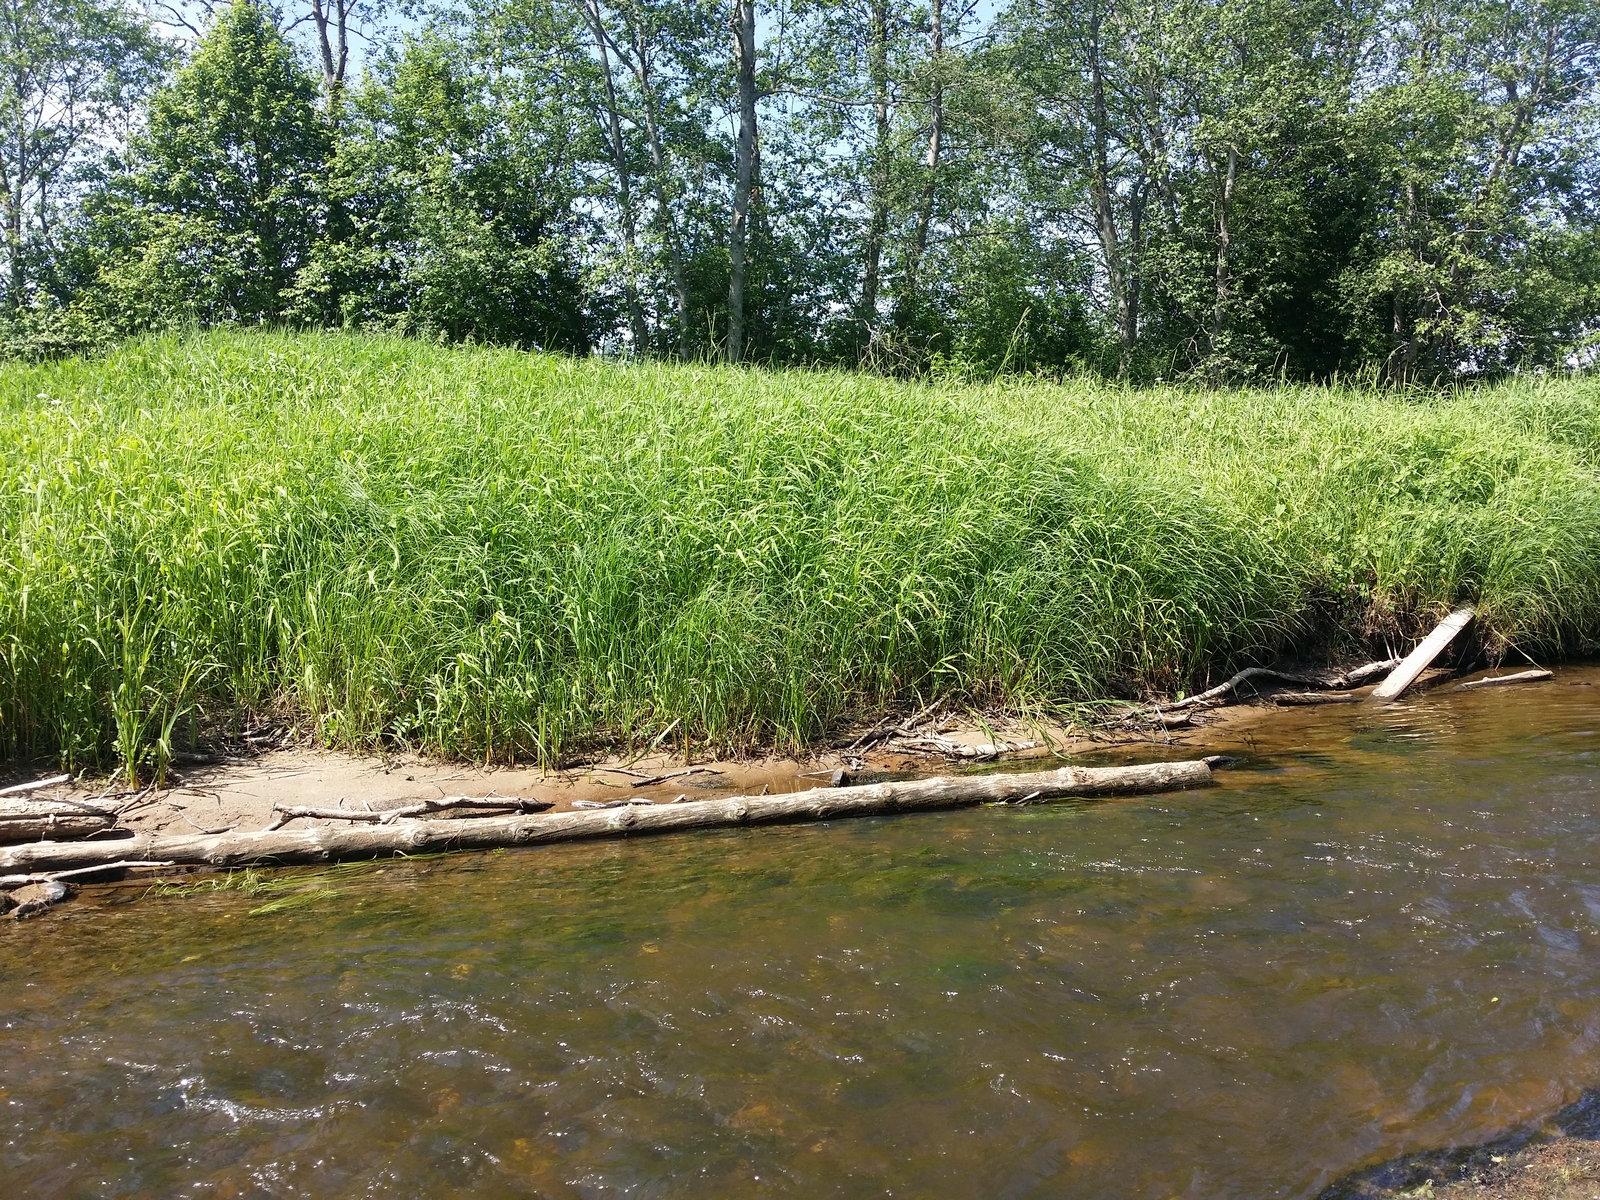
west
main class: Grassland
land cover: Spontaneously vegetated surfaces
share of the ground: 50 - 75 %
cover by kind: herbaceous plants 60 %, unconsolidated bare surface 40 %
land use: Semi-natural and natural areas not in use
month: June
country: LV
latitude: 57.3955
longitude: 26.4657
